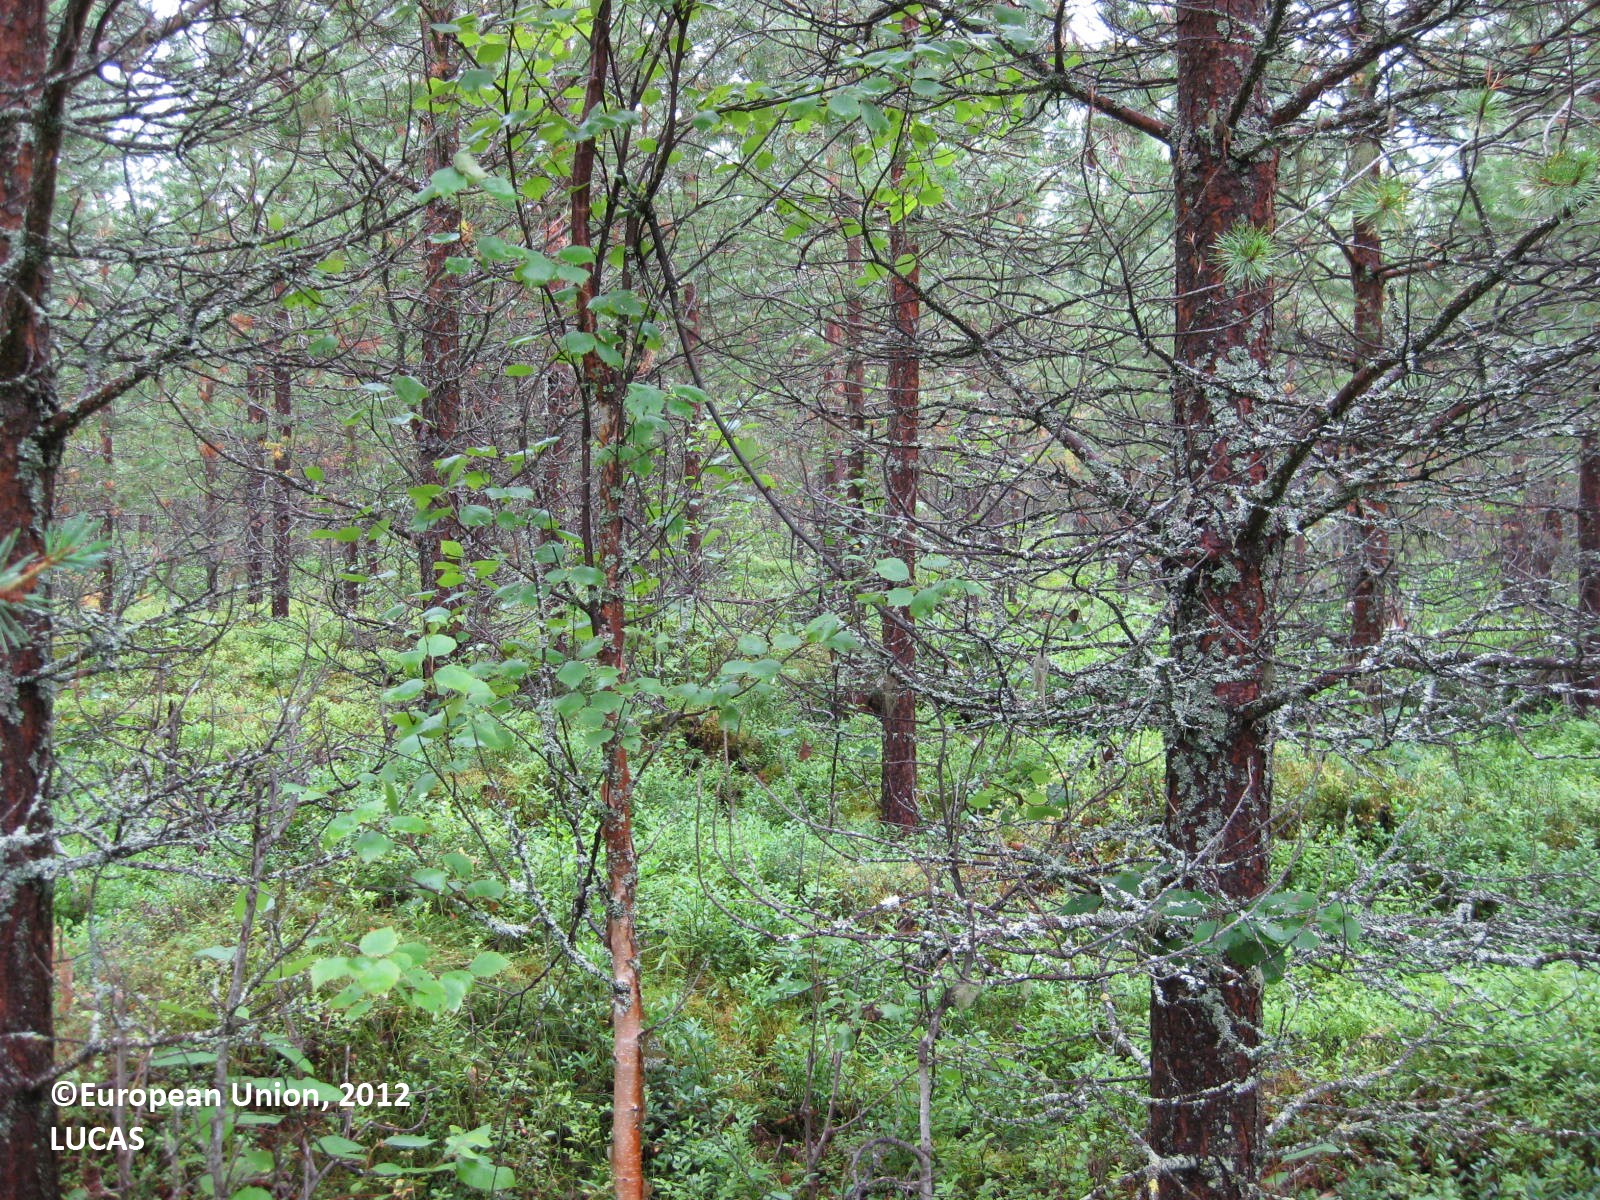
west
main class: Woodland
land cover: Pine dominated coniferous woodland
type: boreal forest
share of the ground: > 75 %
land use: Forestry
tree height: > 5 m
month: August
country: FI
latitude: 65.8719
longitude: 28.1884
